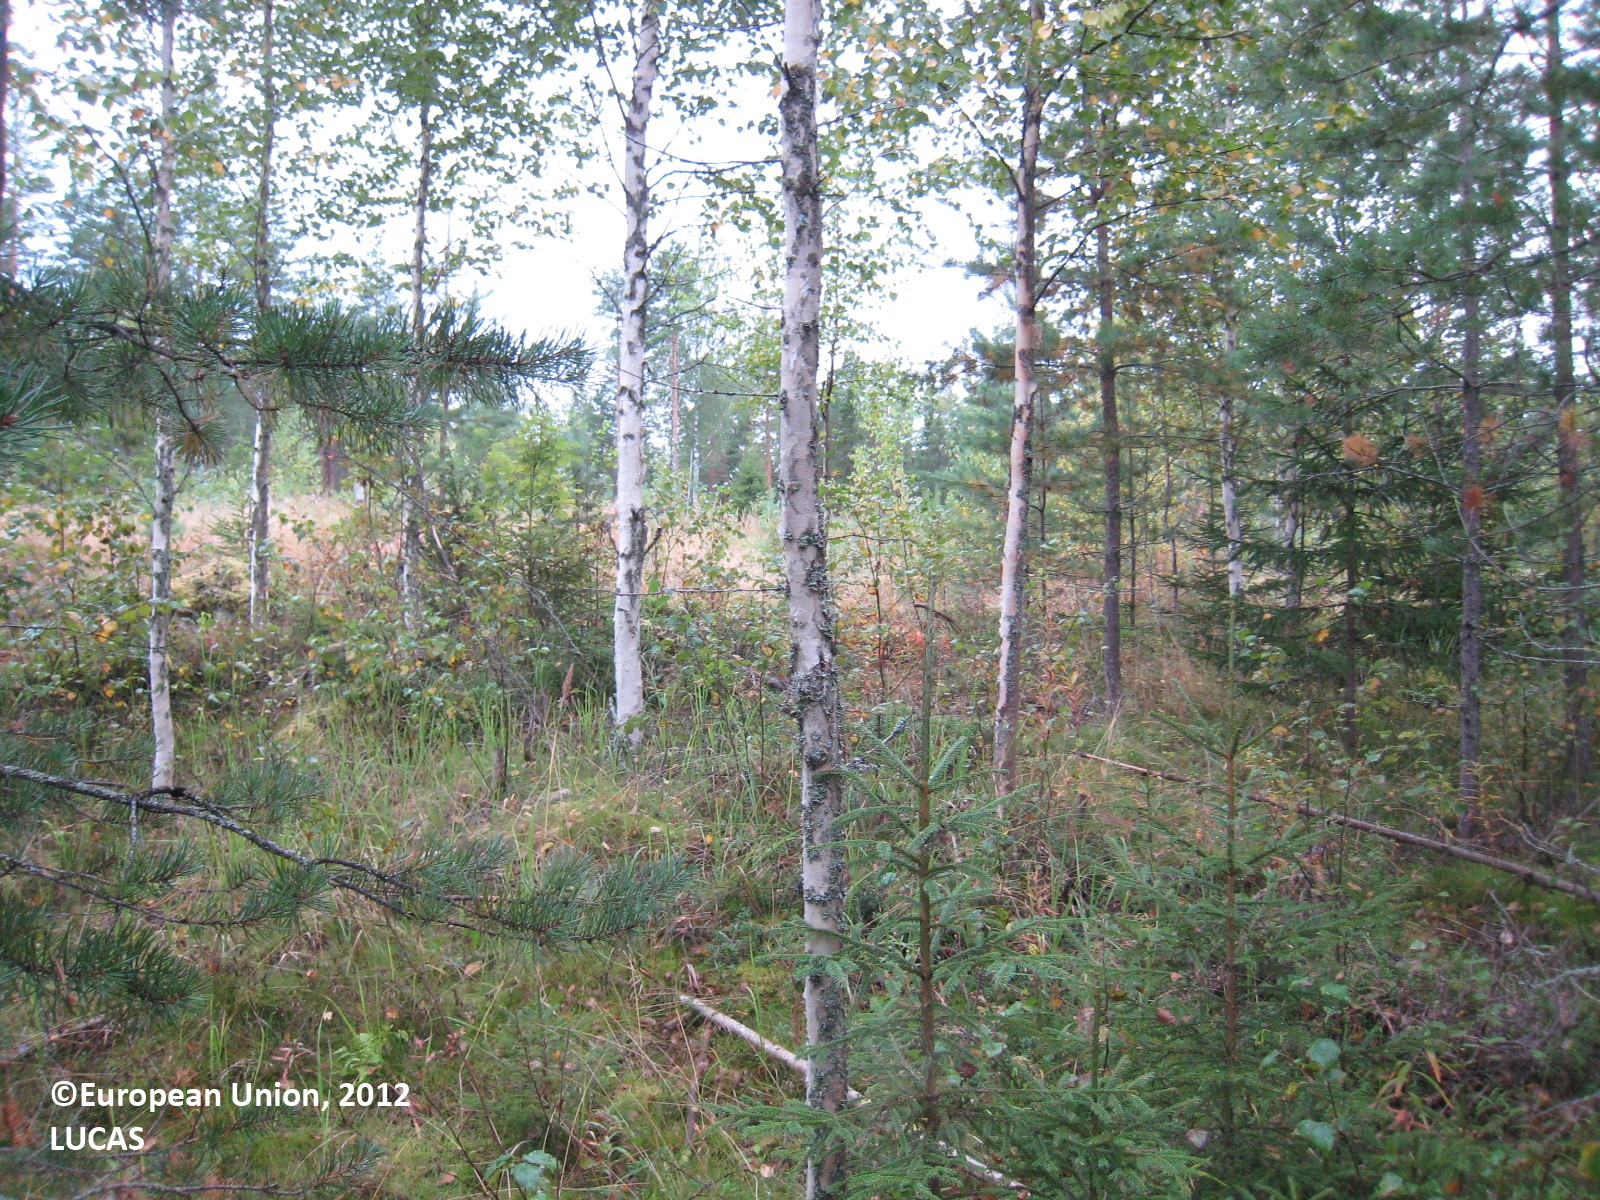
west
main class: Woodland
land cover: Pine dominated mixed woodland
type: boreal forest
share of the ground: > 75 %
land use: Forestry
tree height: > 5 m
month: August
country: FI
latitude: 62.1459
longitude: 27.2182
